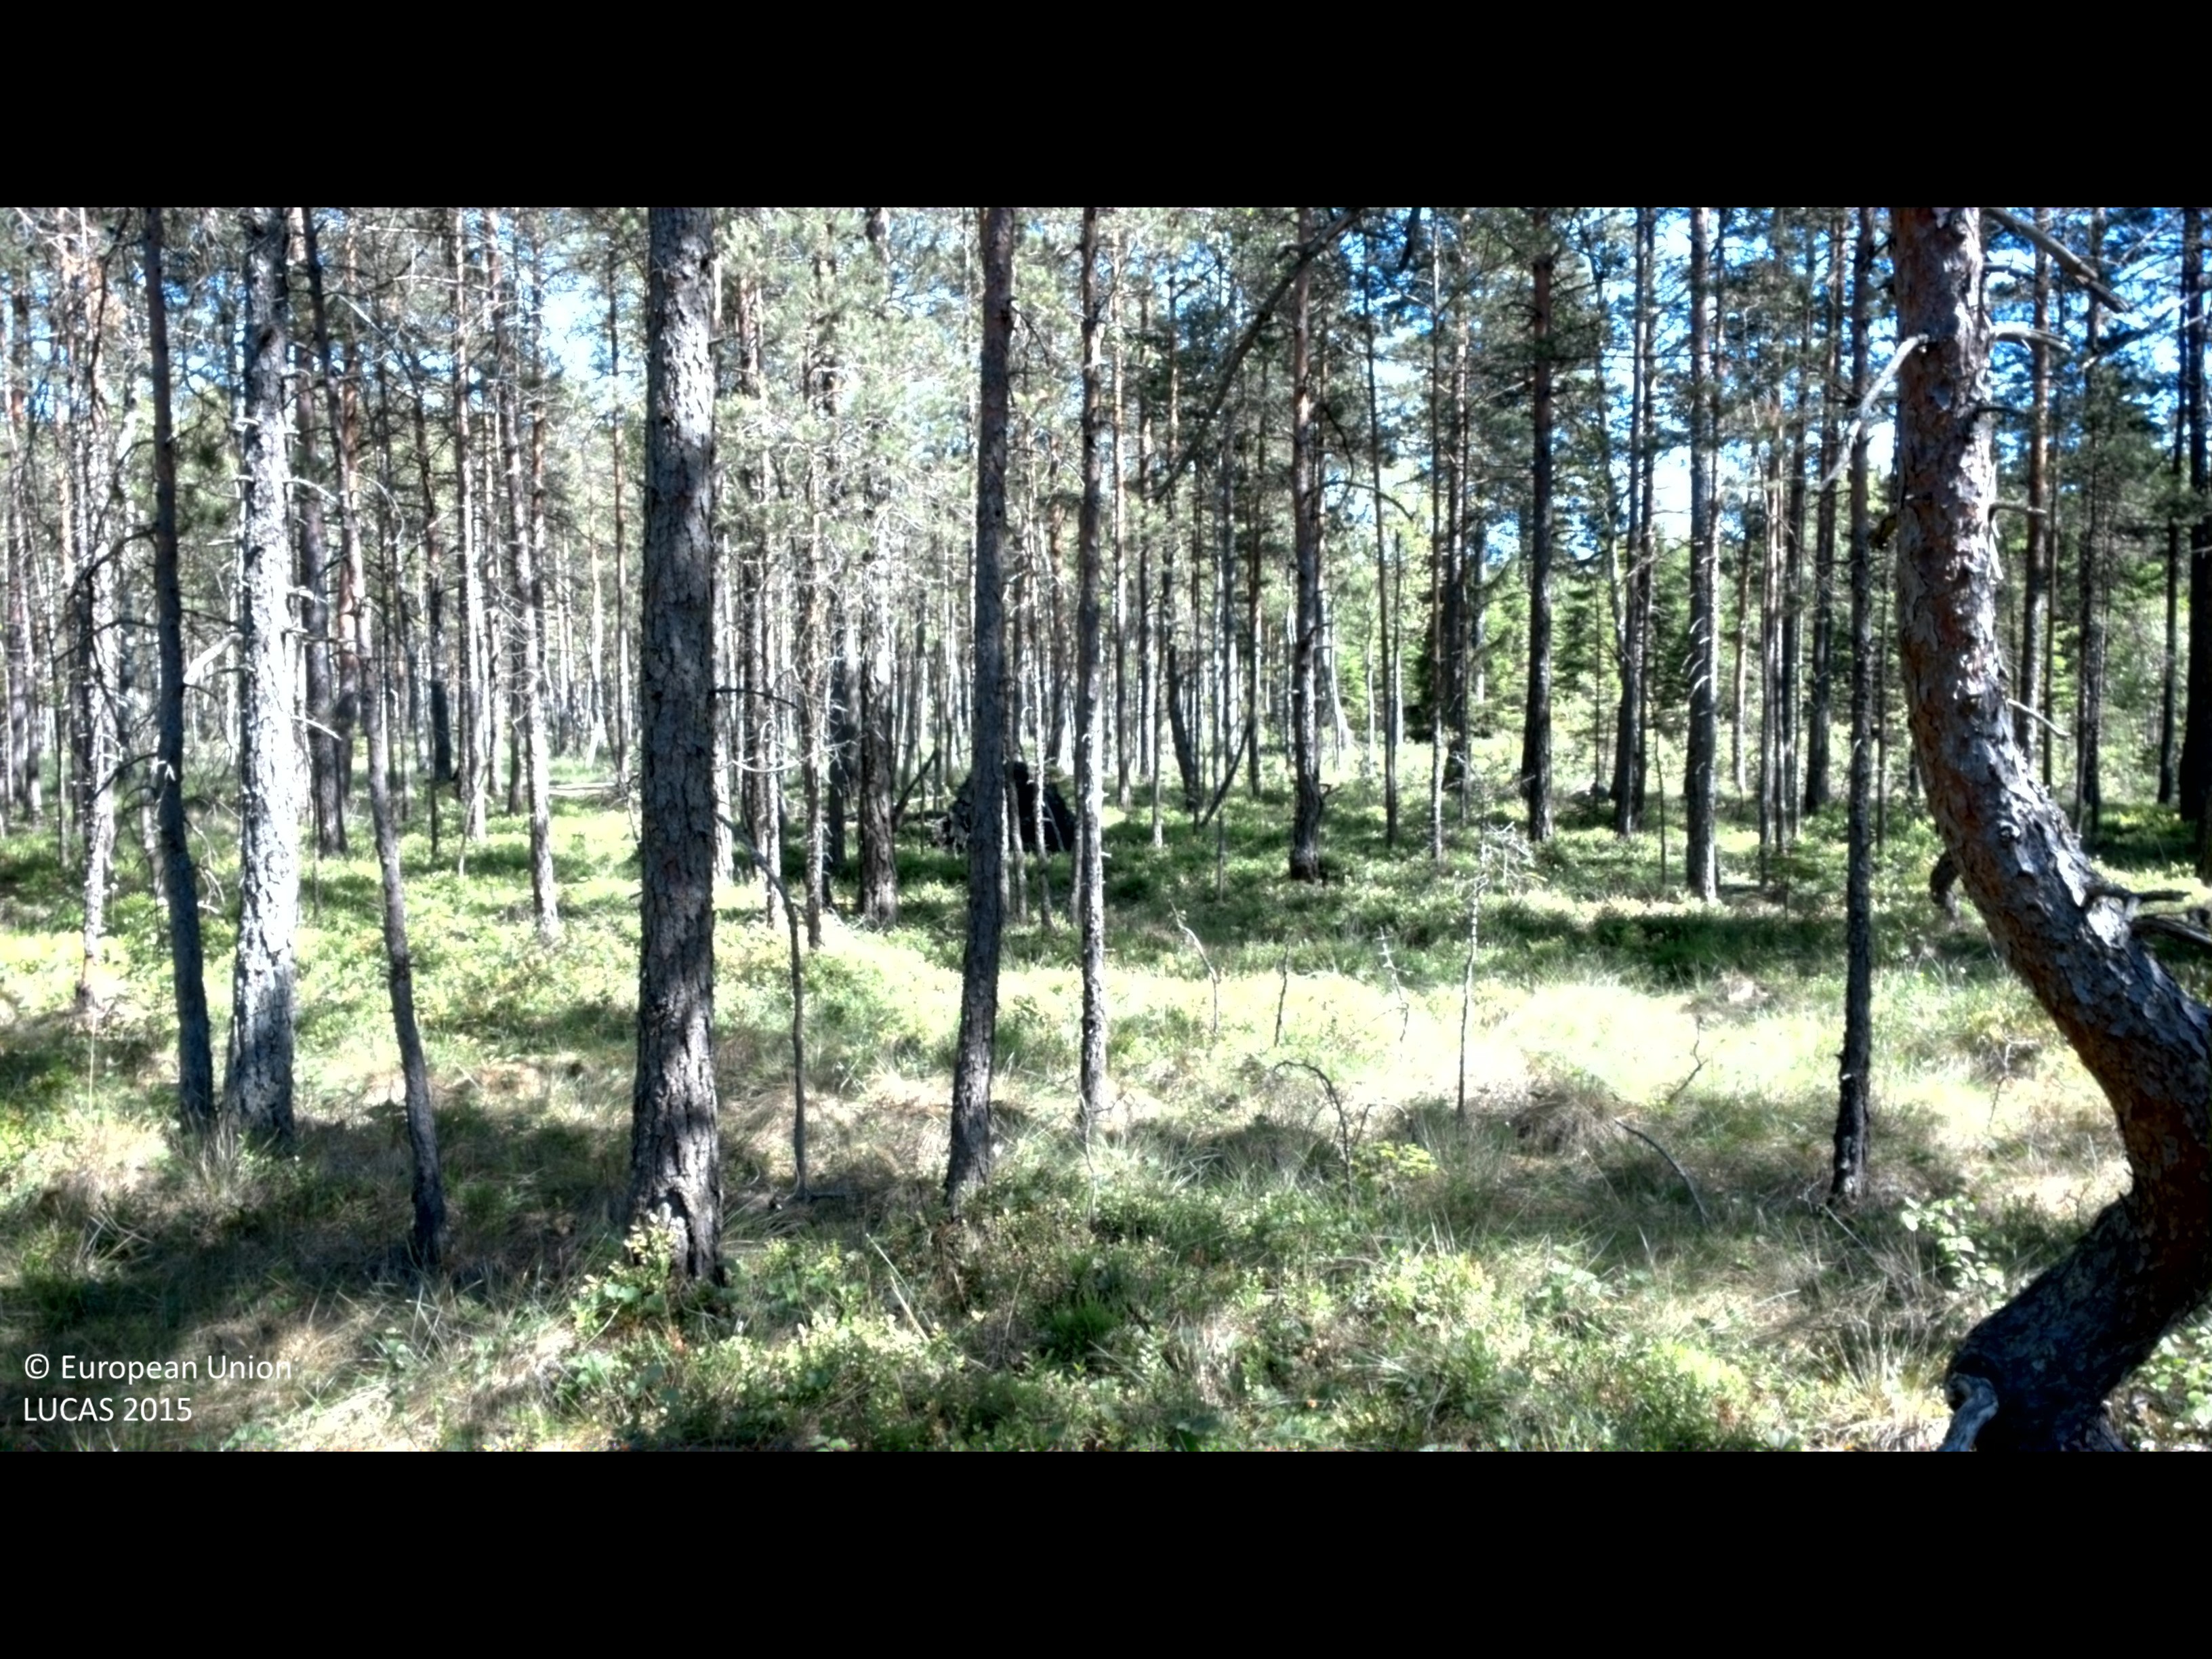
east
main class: Woodland
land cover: Pine dominated coniferous woodland
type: boreal forest
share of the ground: 50 - 75 %
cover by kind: coniferous forest trees 60 %, shrubs 20 %, herbaceous plants 10 %, lichens and mosses 10 %
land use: Forestry
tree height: > 5 m
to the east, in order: Pine dominated coniferous woodland; Pine dominated mixed woodland; Pine dominated coniferous woodland
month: July
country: SE
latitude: 56.5220
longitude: 14.5326
